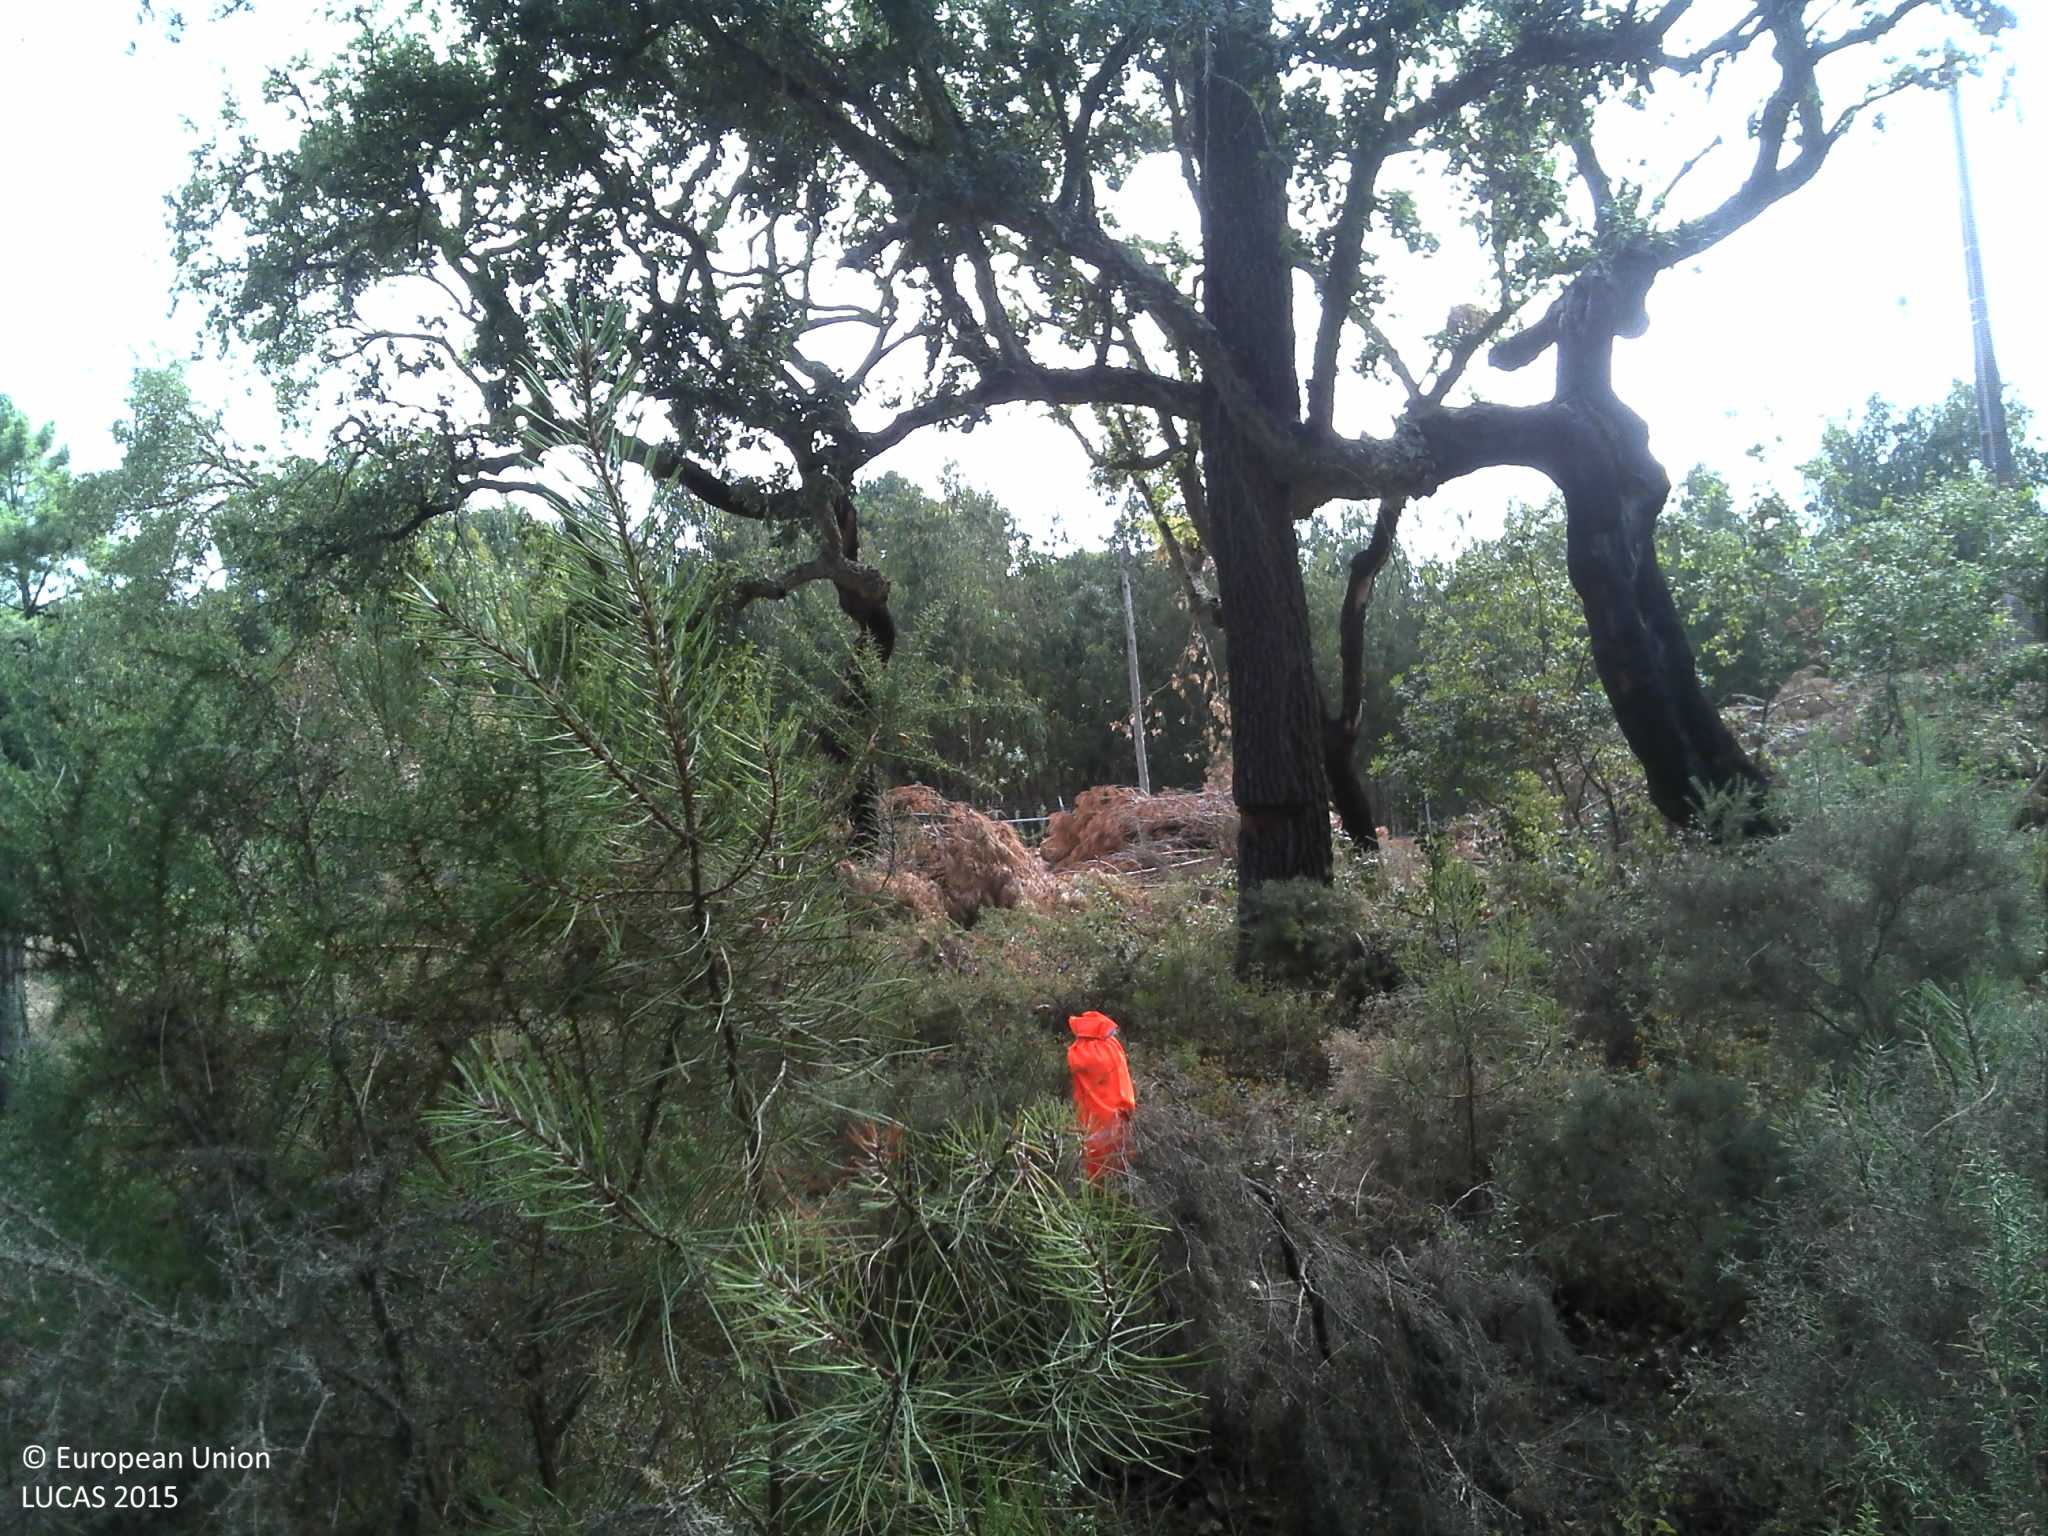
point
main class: Woodland
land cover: Pine dominated mixed woodland
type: coniferous forest of the mediterranean region
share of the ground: 50 - 75 %
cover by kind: coniferous forest trees 35 %, broadleaved forest trees 30 %, shrubs 20 %, unconsolidated bare surface 15 %
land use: Forestry
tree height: > 5 m
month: June
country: PT
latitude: 38.4802
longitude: -9.1098
